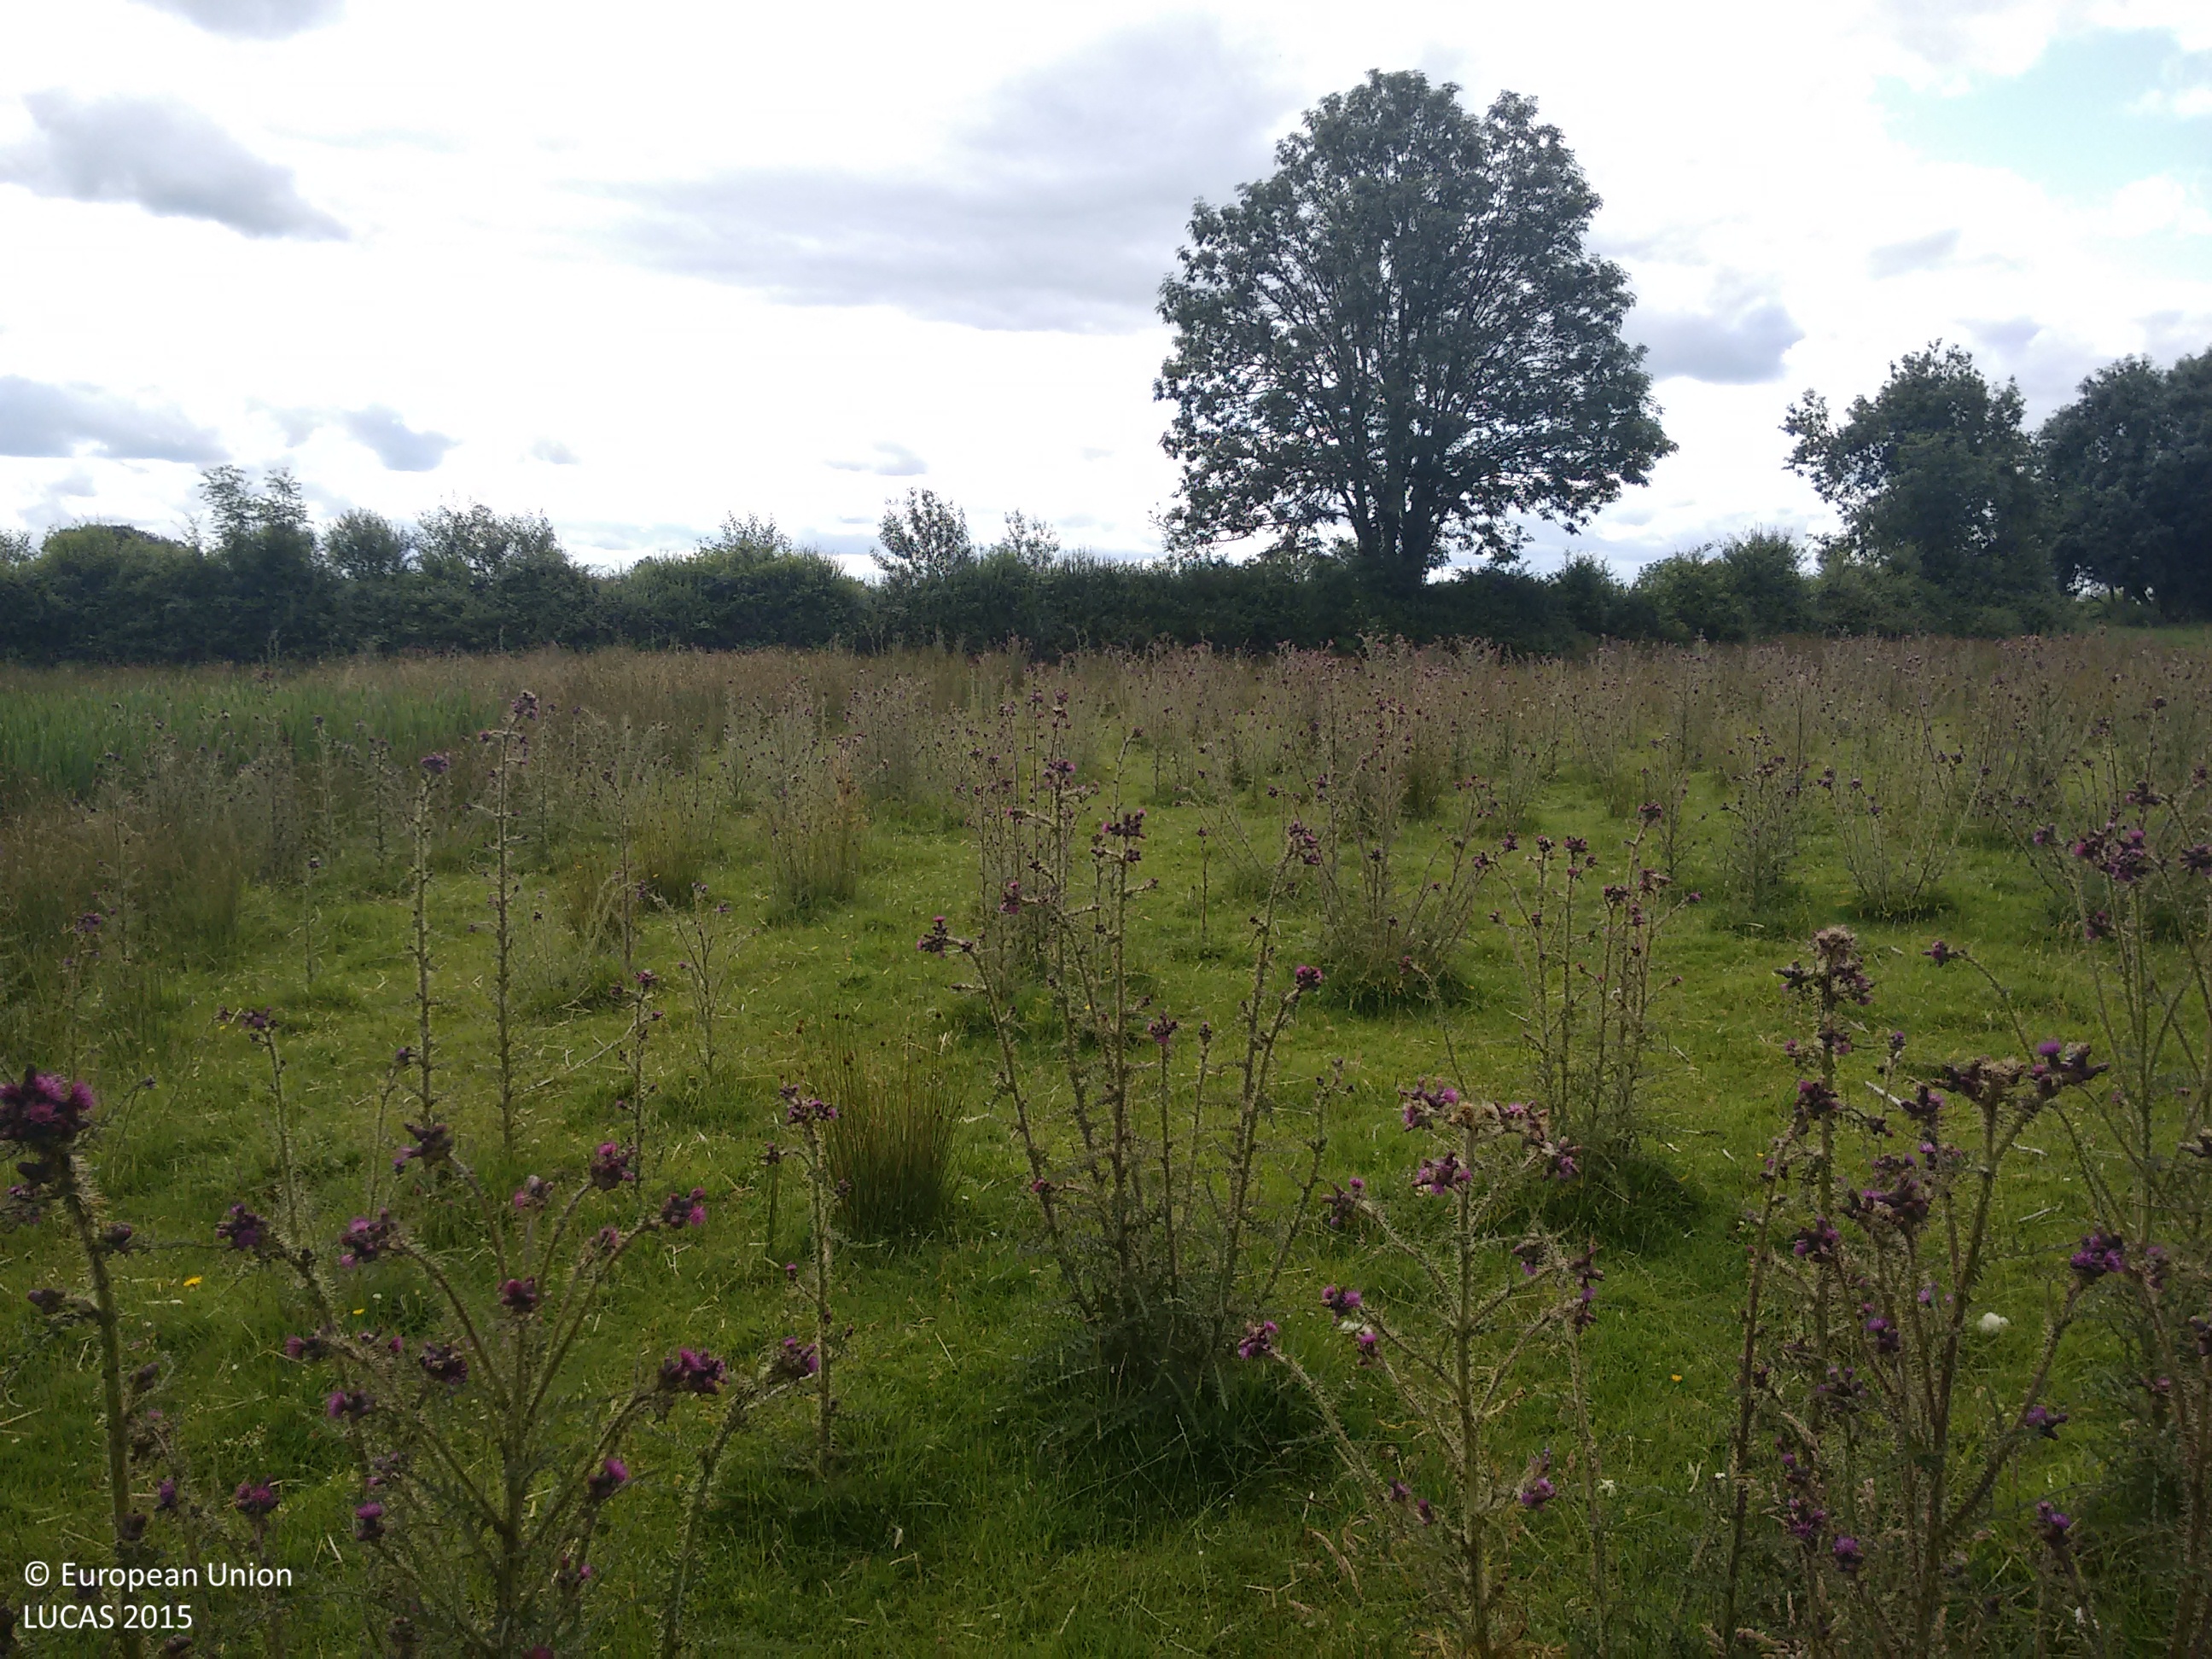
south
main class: Grassland
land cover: Grassland without tree/shrub cover
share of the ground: > 75 %
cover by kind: herbaceous plants 95 %, shrubs 5 %
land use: Agriculture (excluding fallow land and kitchen gardens)
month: July
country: IE
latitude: 53.5544
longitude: -7.8456
